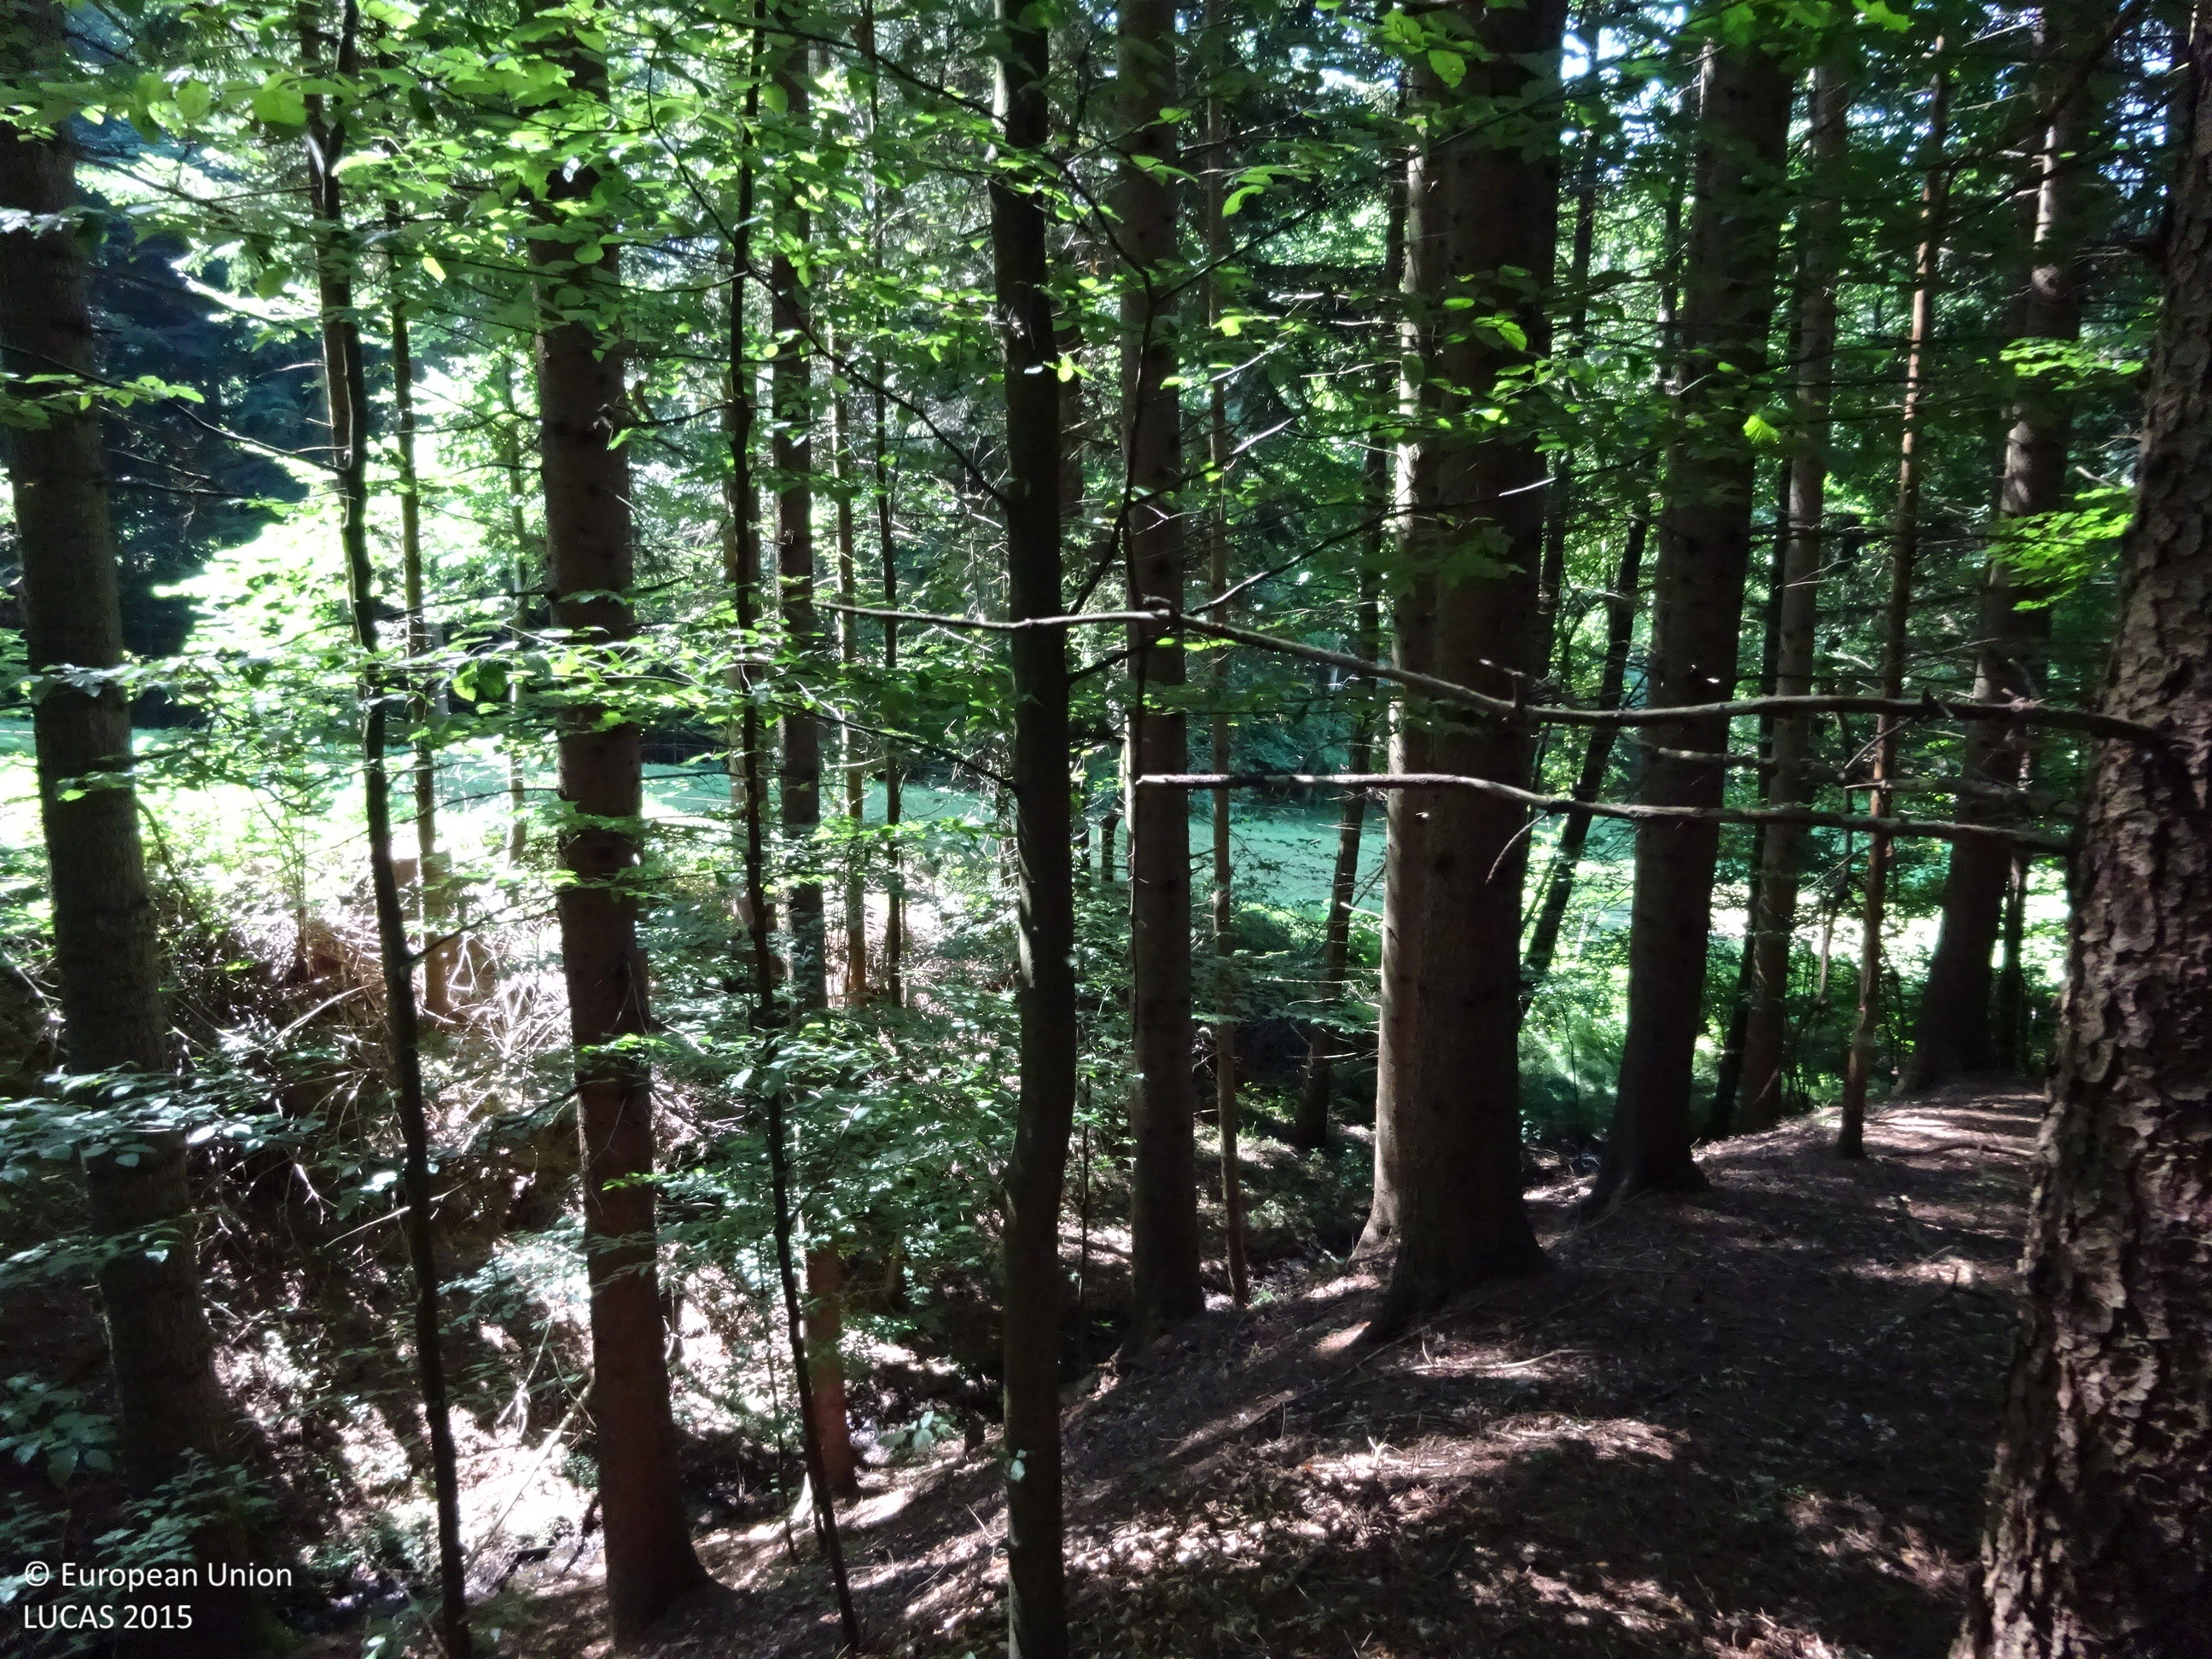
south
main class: Woodland
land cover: Spruce dominated coniferous woodland
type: alpine coniferous forest
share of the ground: > 75 %
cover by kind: coniferous forest trees 95 %, broadleaved forest trees 5 %
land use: Forestry
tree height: > 5 m
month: August
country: AT
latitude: 47.4596
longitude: 16.0910
